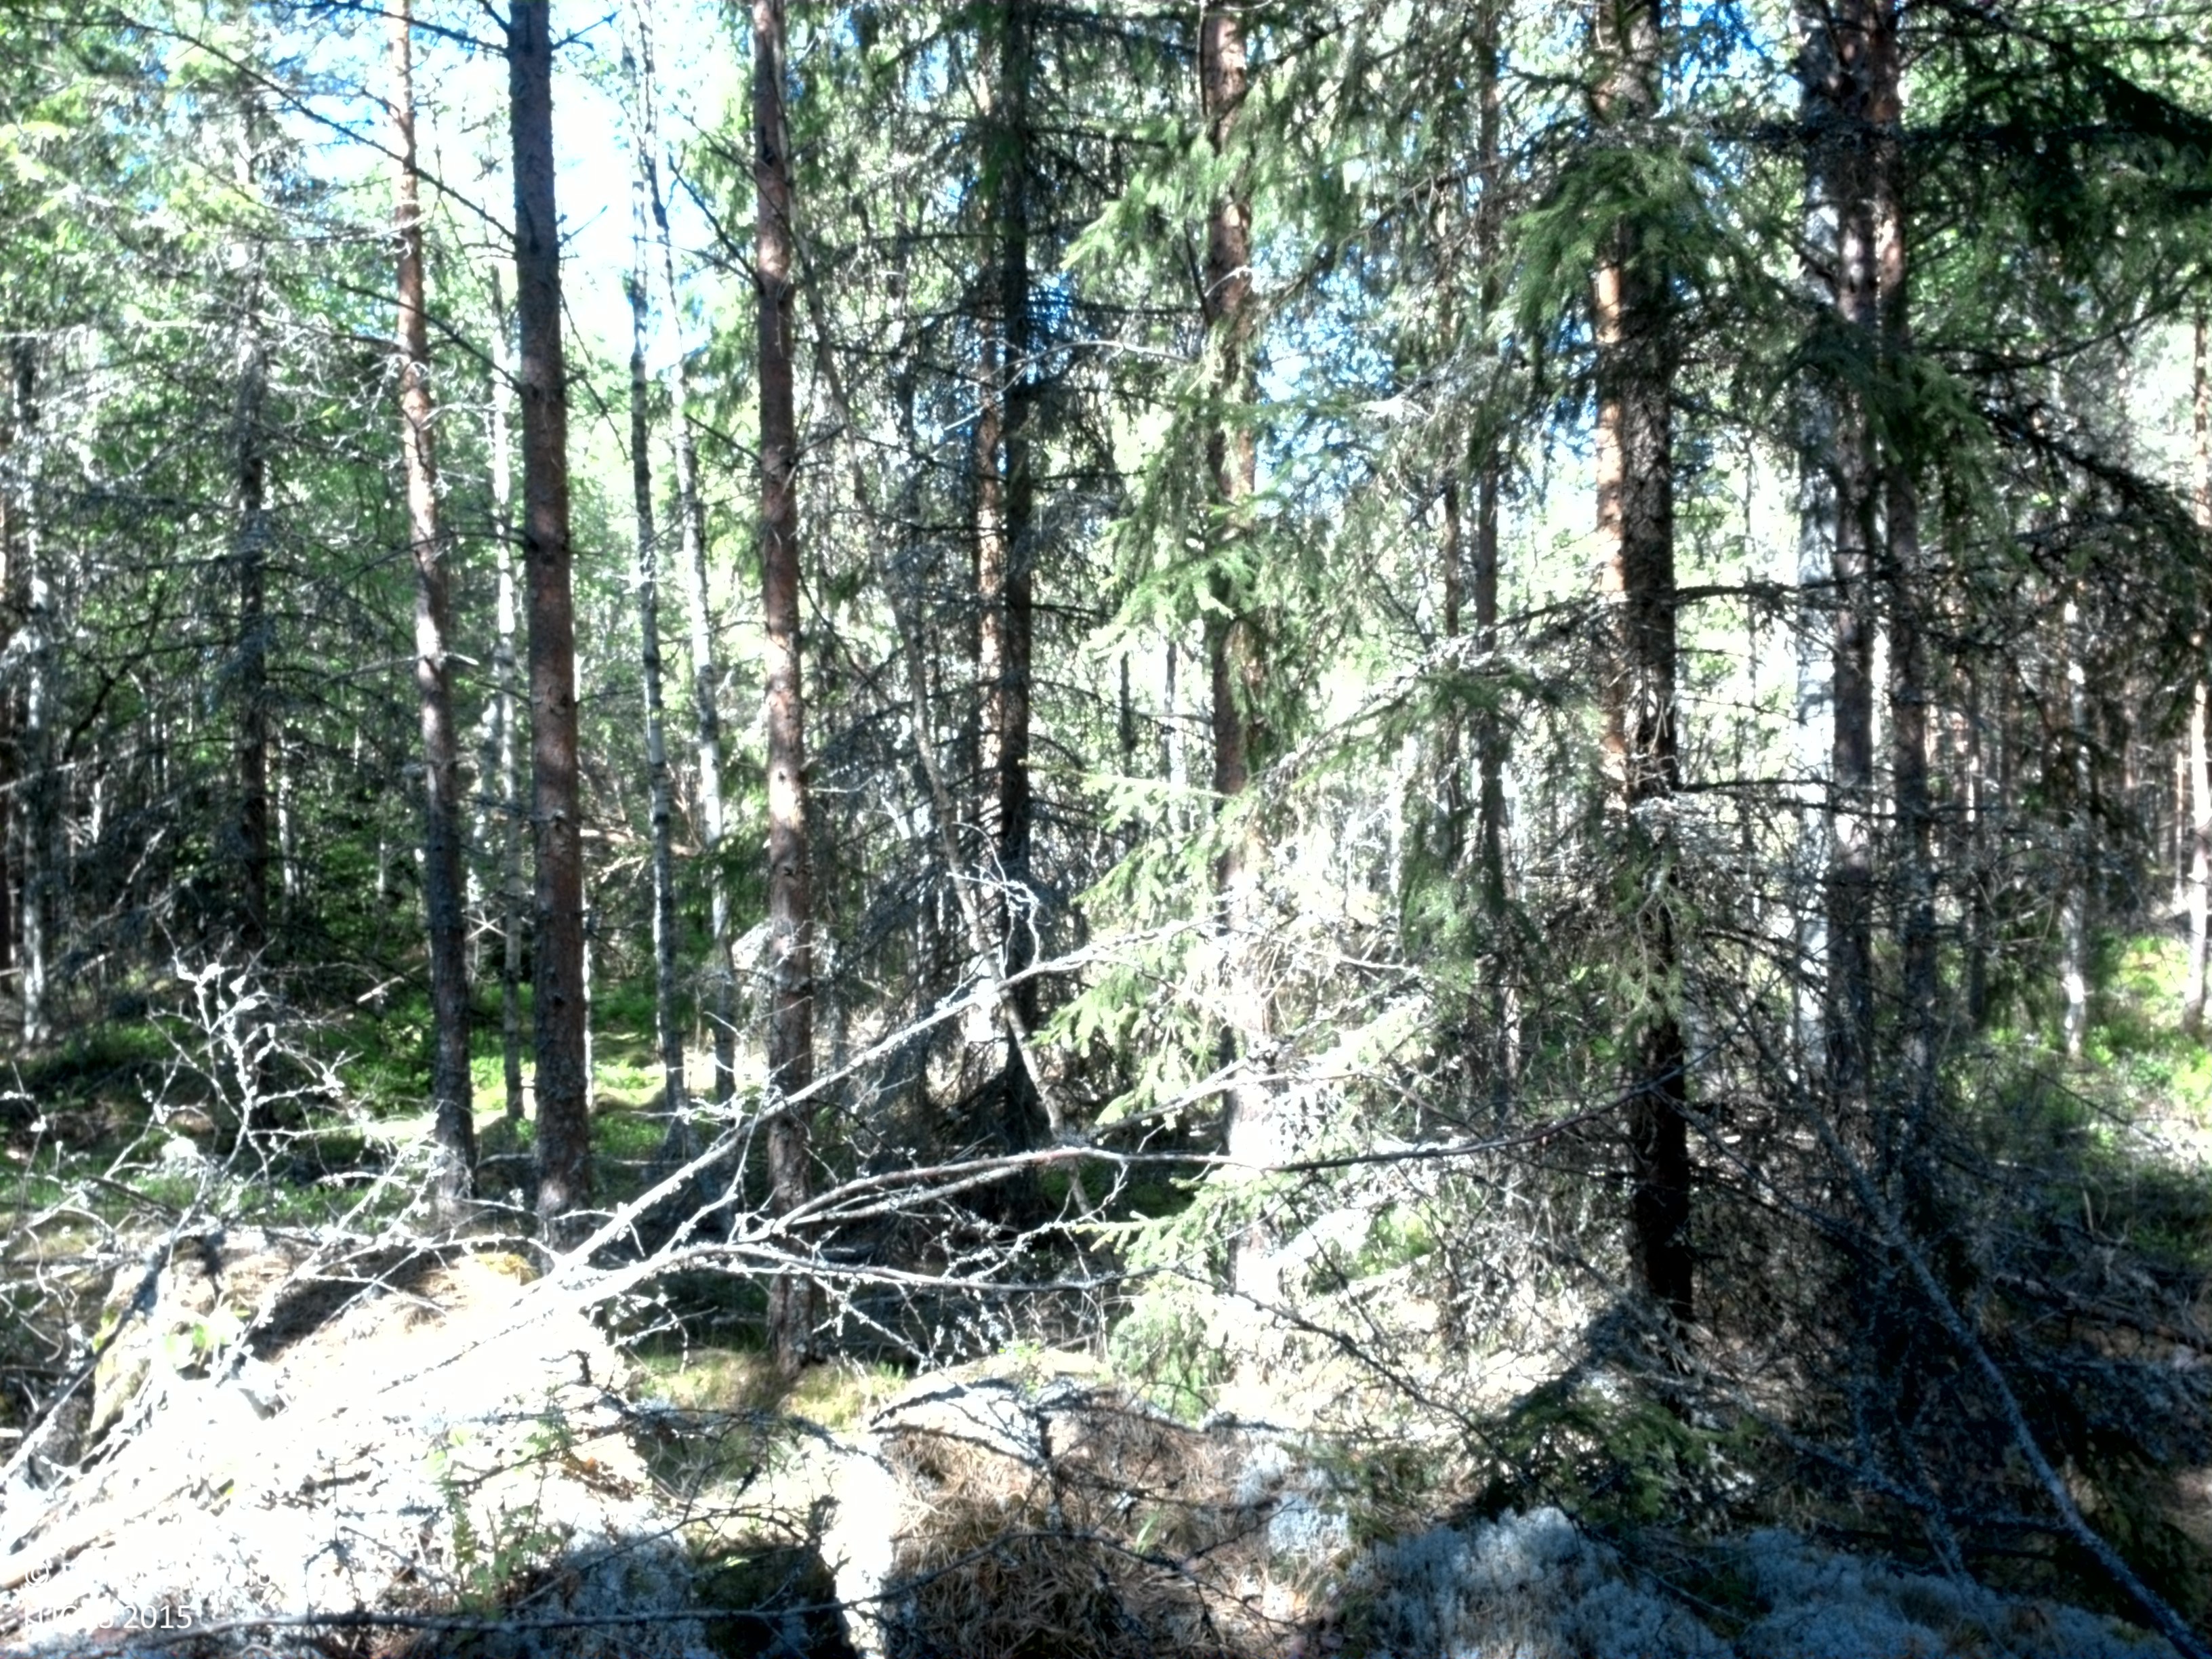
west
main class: Woodland
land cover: Pine dominated coniferous woodland
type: boreal forest
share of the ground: > 75 %
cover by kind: coniferous forest trees 65 %, broadleaved forest trees 10 %, shrubs 10 %, lichens and mosses 10 %, herbaceous plants 5 %
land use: Forestry
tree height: > 5 m
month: May
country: SE
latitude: 57.4013
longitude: 15.9726
